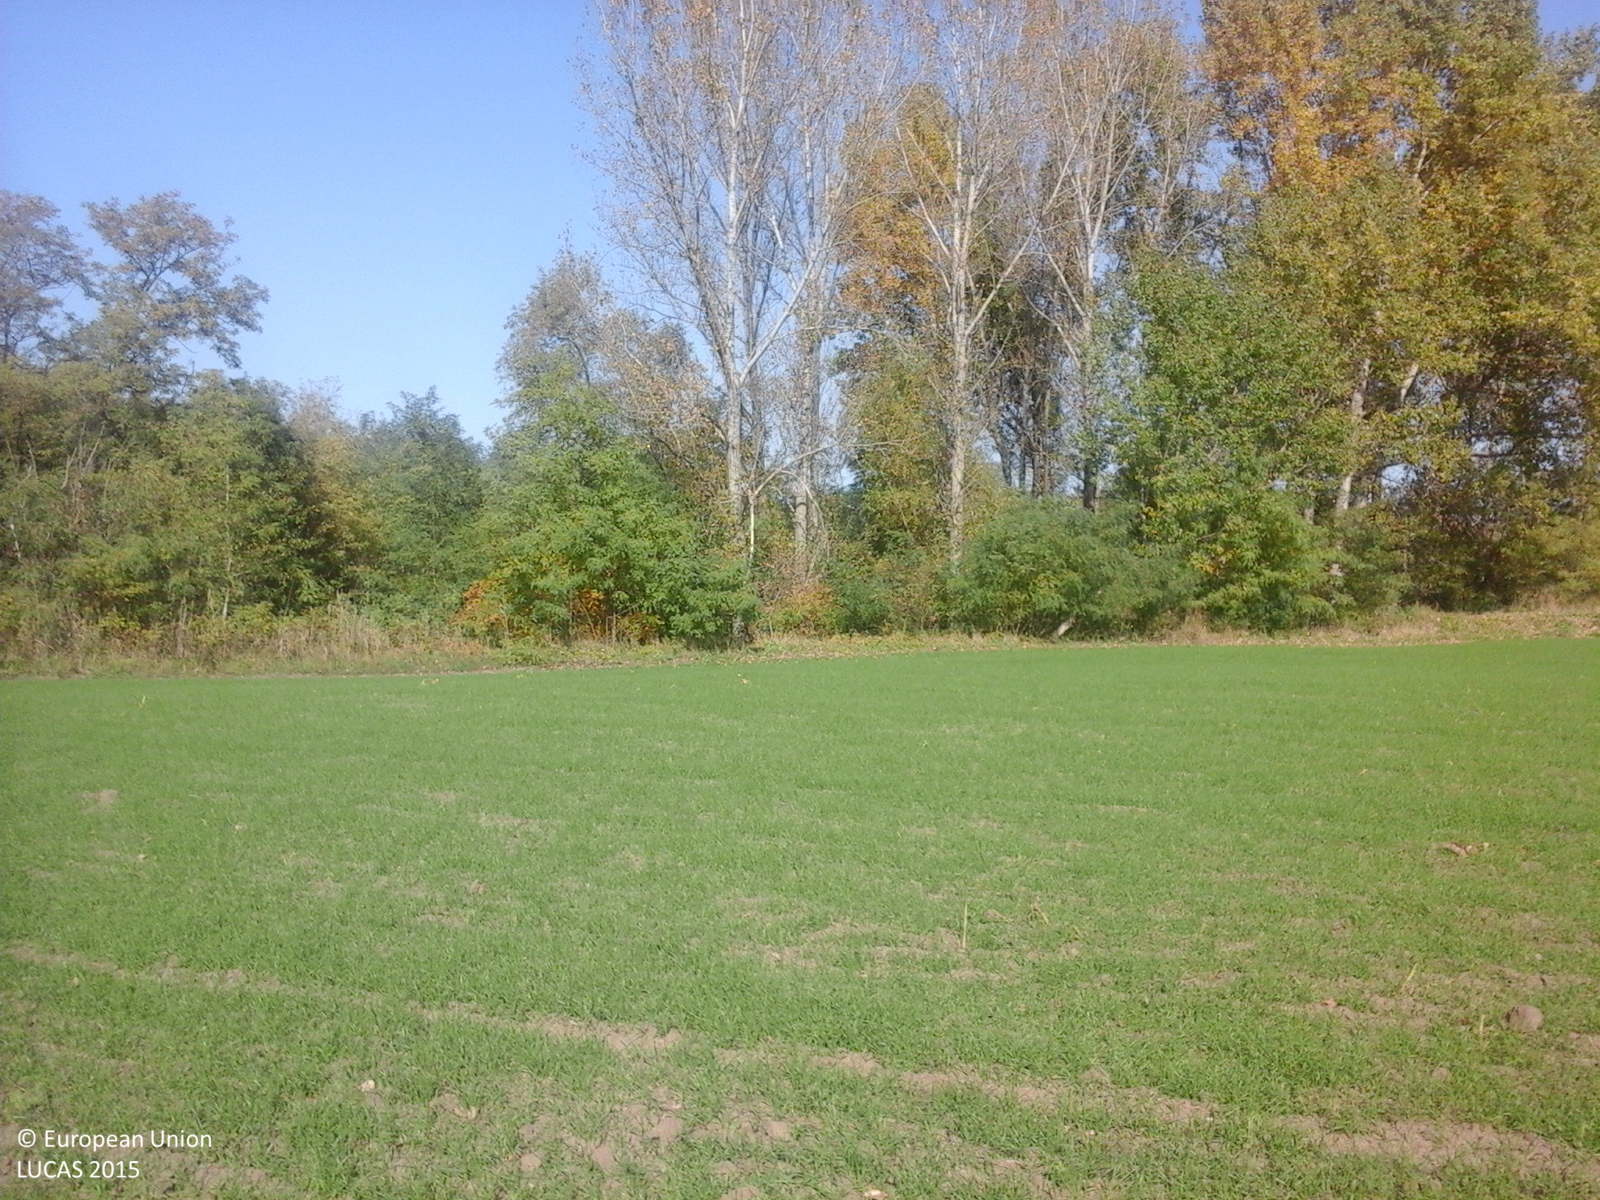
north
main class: Cropland
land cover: Common wheat
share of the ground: > 75 %
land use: Agriculture (excluding fallow land and kitchen gardens)
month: October
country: RO
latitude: 45.3258
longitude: 26.7810
